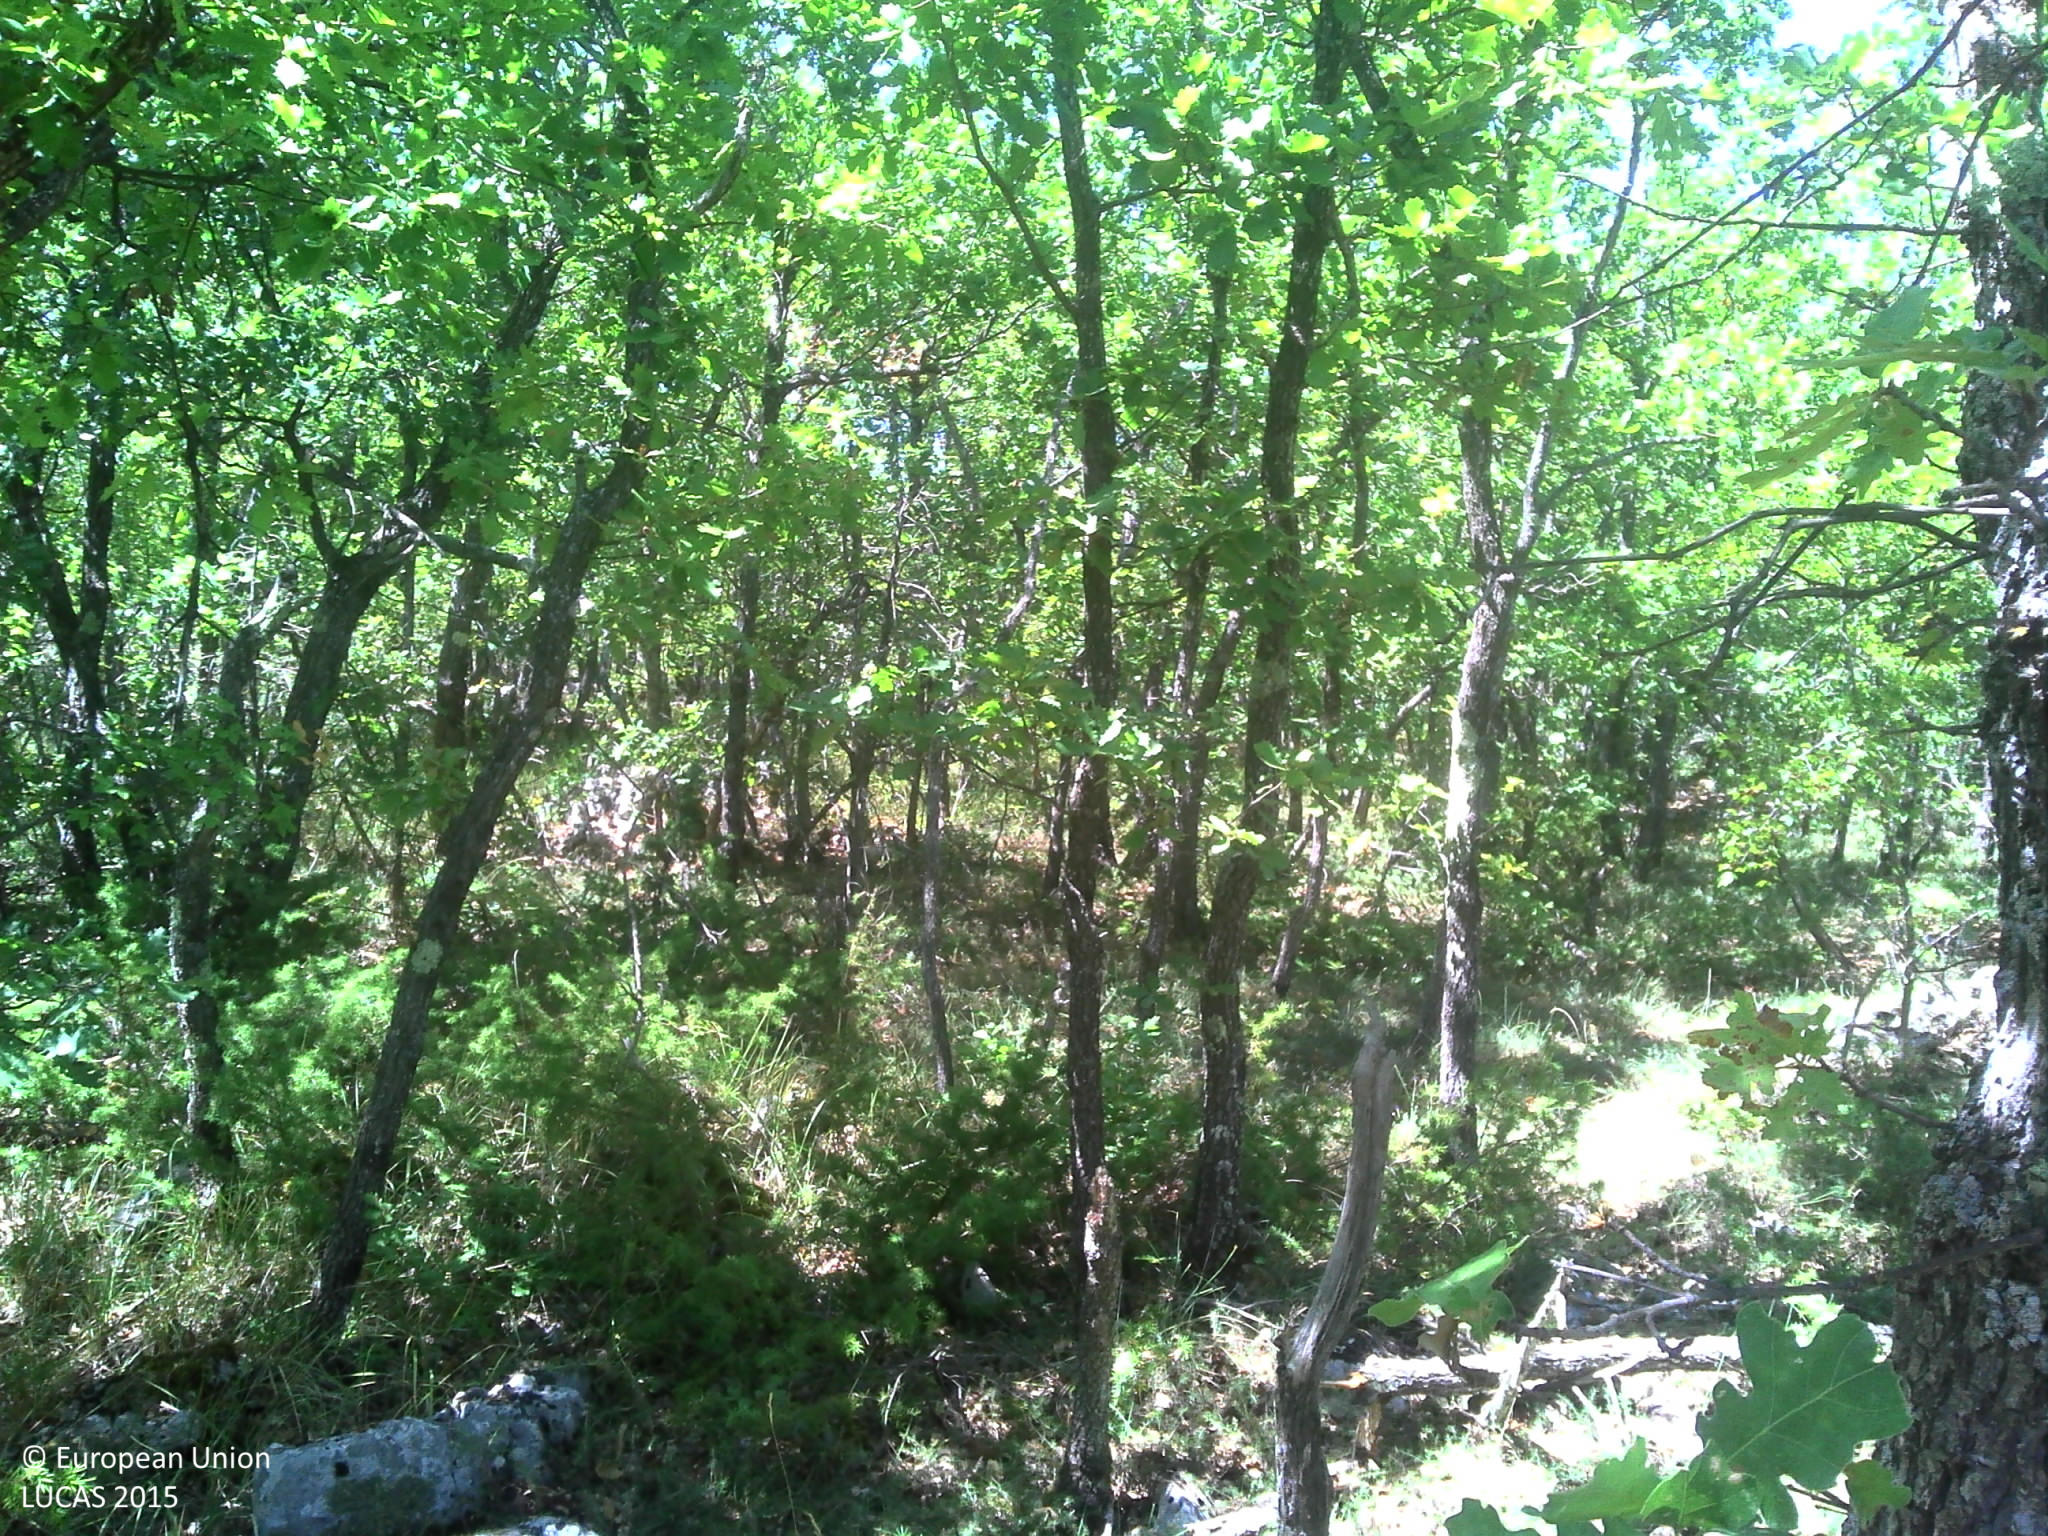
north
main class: Woodland
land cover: Broadleaved woodland
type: thermophilous deciduous forest
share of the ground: 50 - 75 %
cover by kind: broadleaved forest trees 70 %, shrubs 10 %, herbaceous plants 10 %, consolidated bare surface 10 %
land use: Forestry
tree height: > 5 m
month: July
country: FR
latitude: 43.9485
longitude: 5.5602
